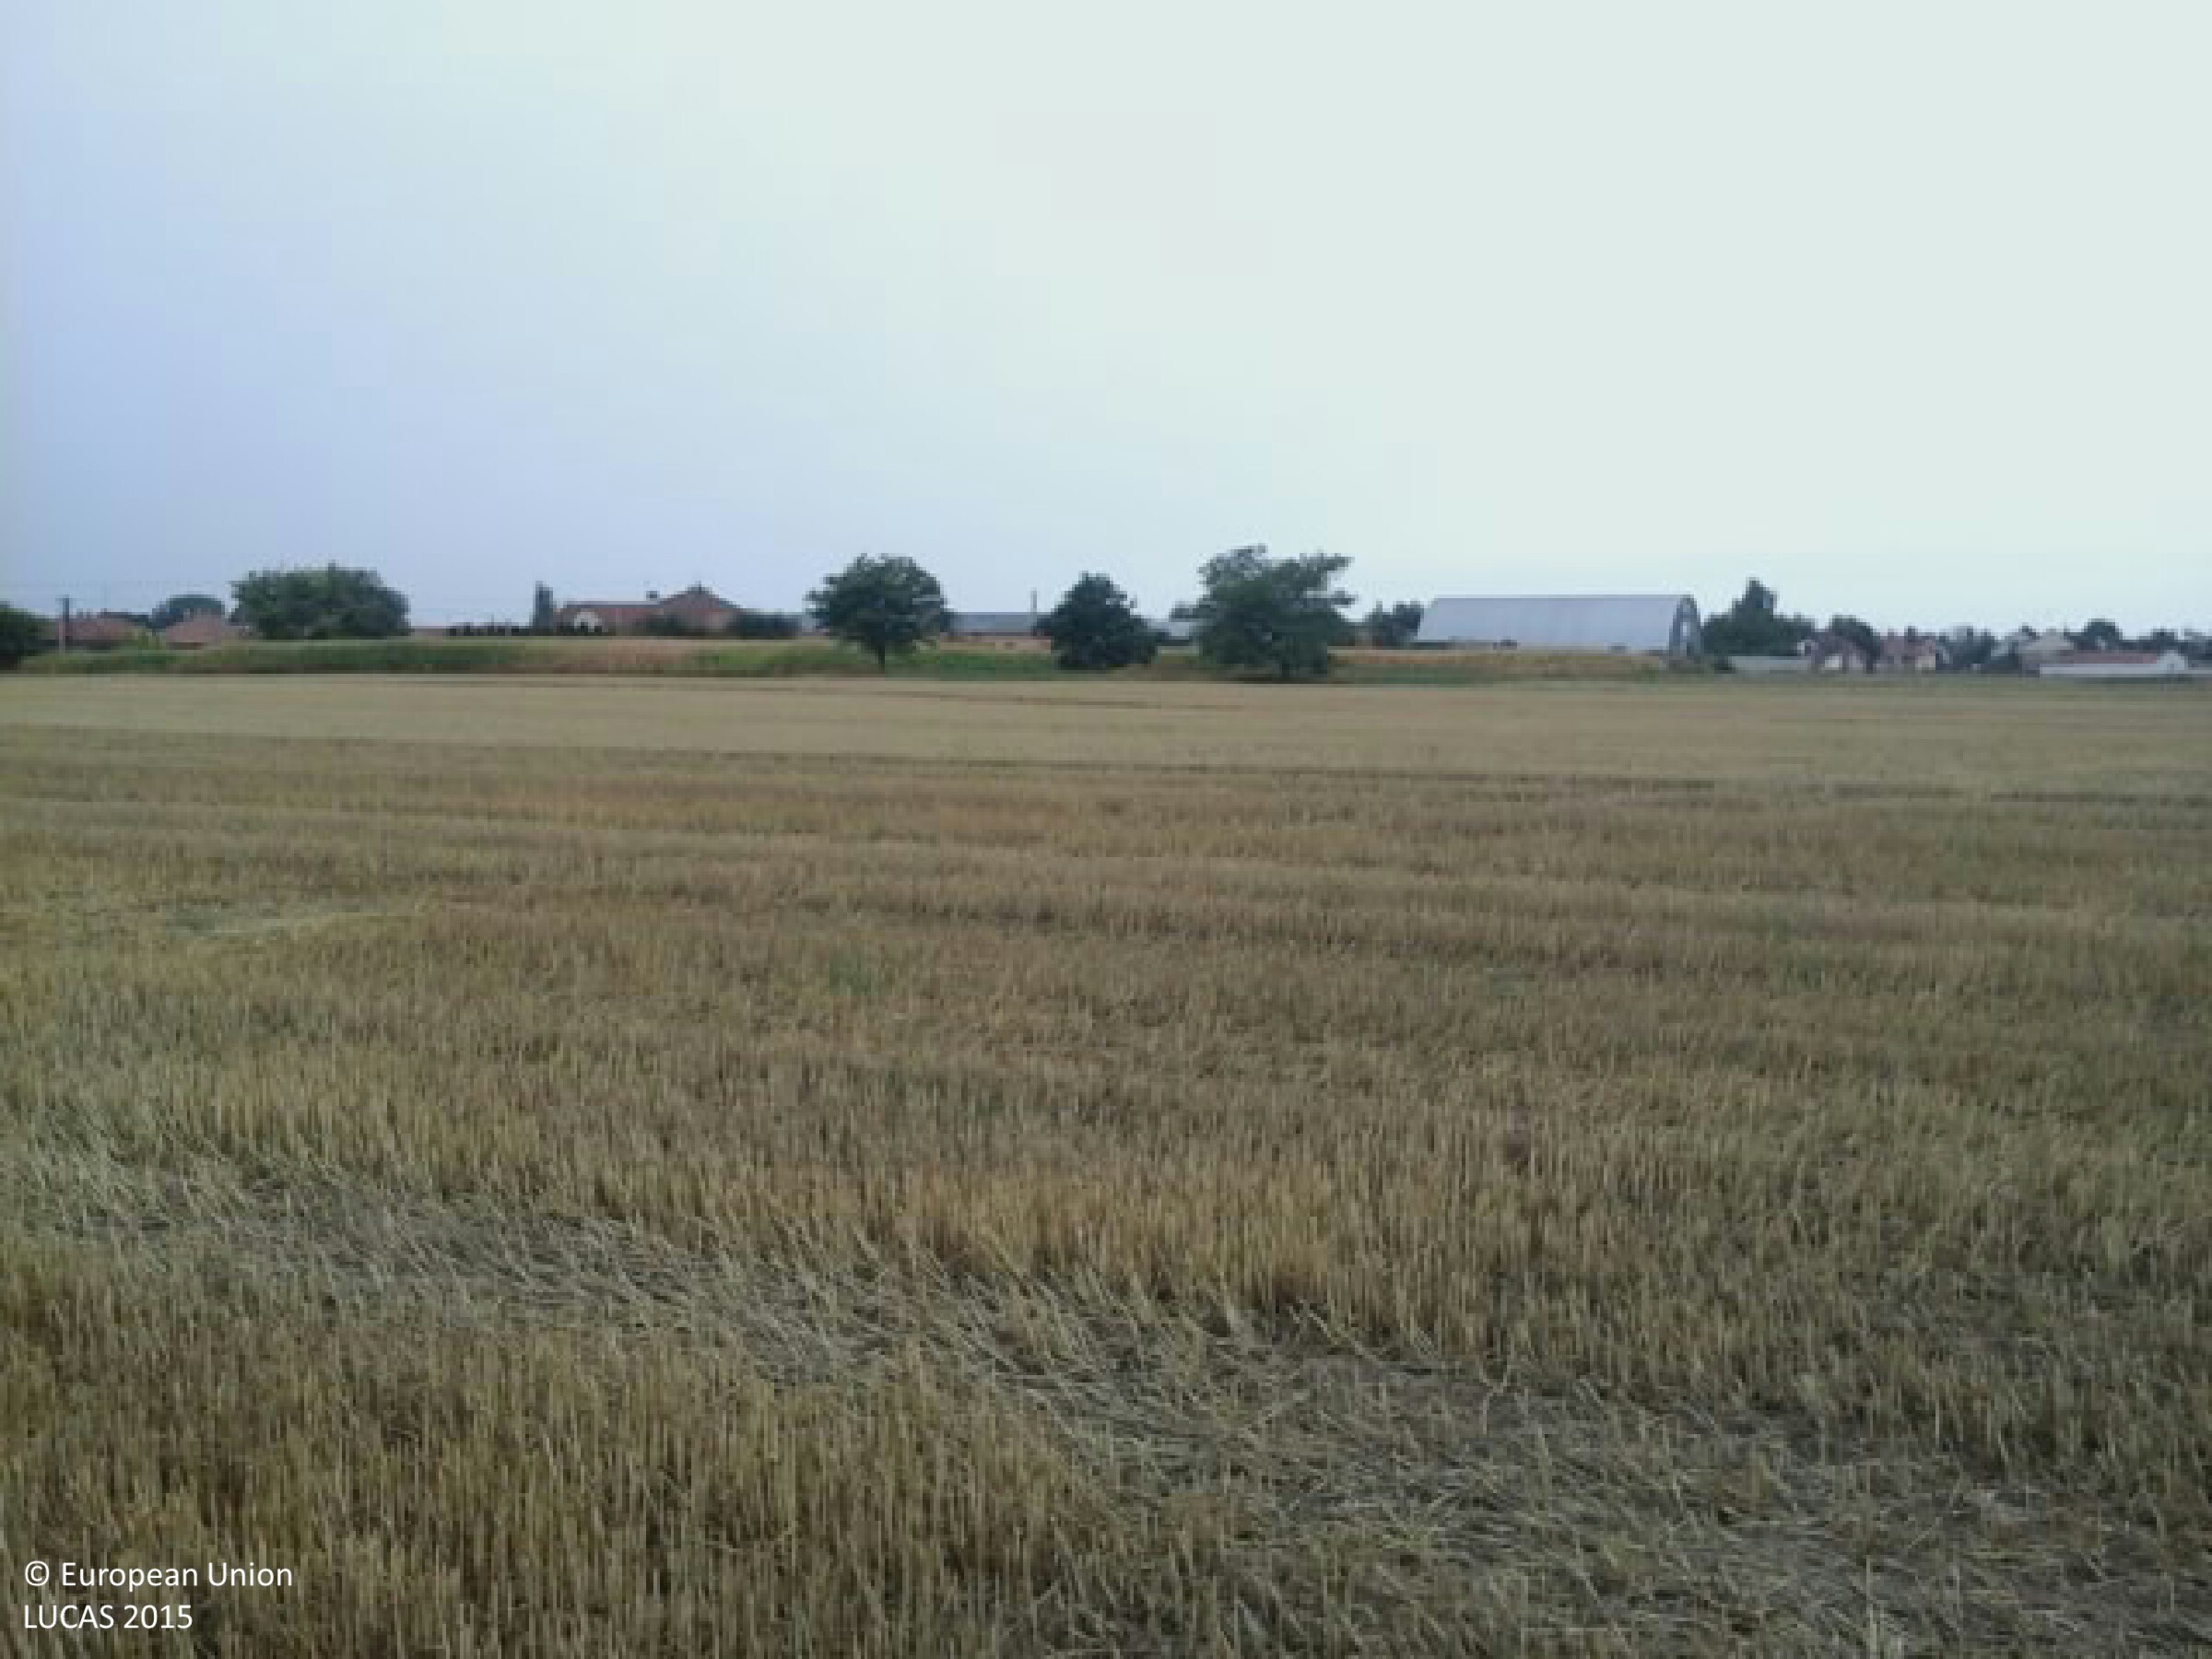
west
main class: Cropland
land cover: Common wheat
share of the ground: 10 - 25 %
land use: Agriculture (excluding fallow land and kitchen gardens)
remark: Harvested field
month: July
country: HU
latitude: 47.0425
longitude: 19.8013
